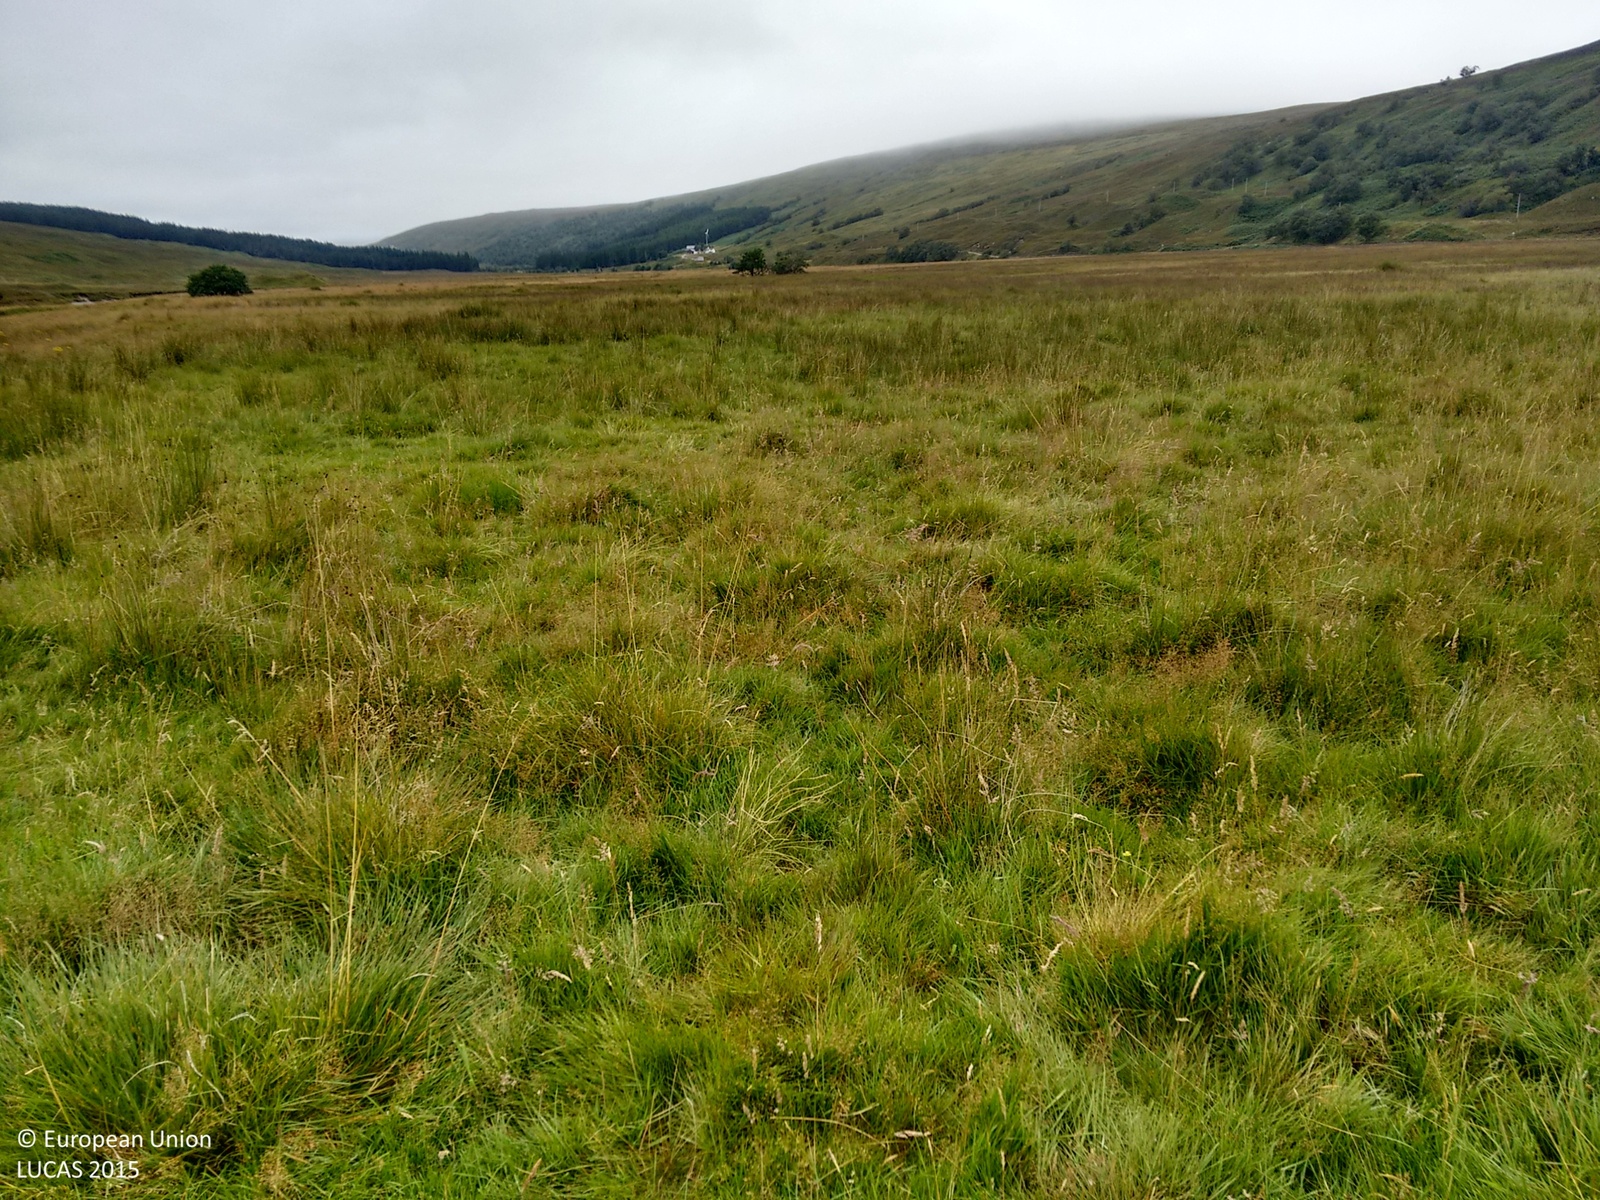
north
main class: Shrubland
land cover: Shrubland without tree cover
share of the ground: > 75 %
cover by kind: shrubs 75 %, herbaceous plants 25 %
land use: Agriculture (excluding fallow land and kitchen gardens)
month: September
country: GB
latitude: 58.0977
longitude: -4.7341
